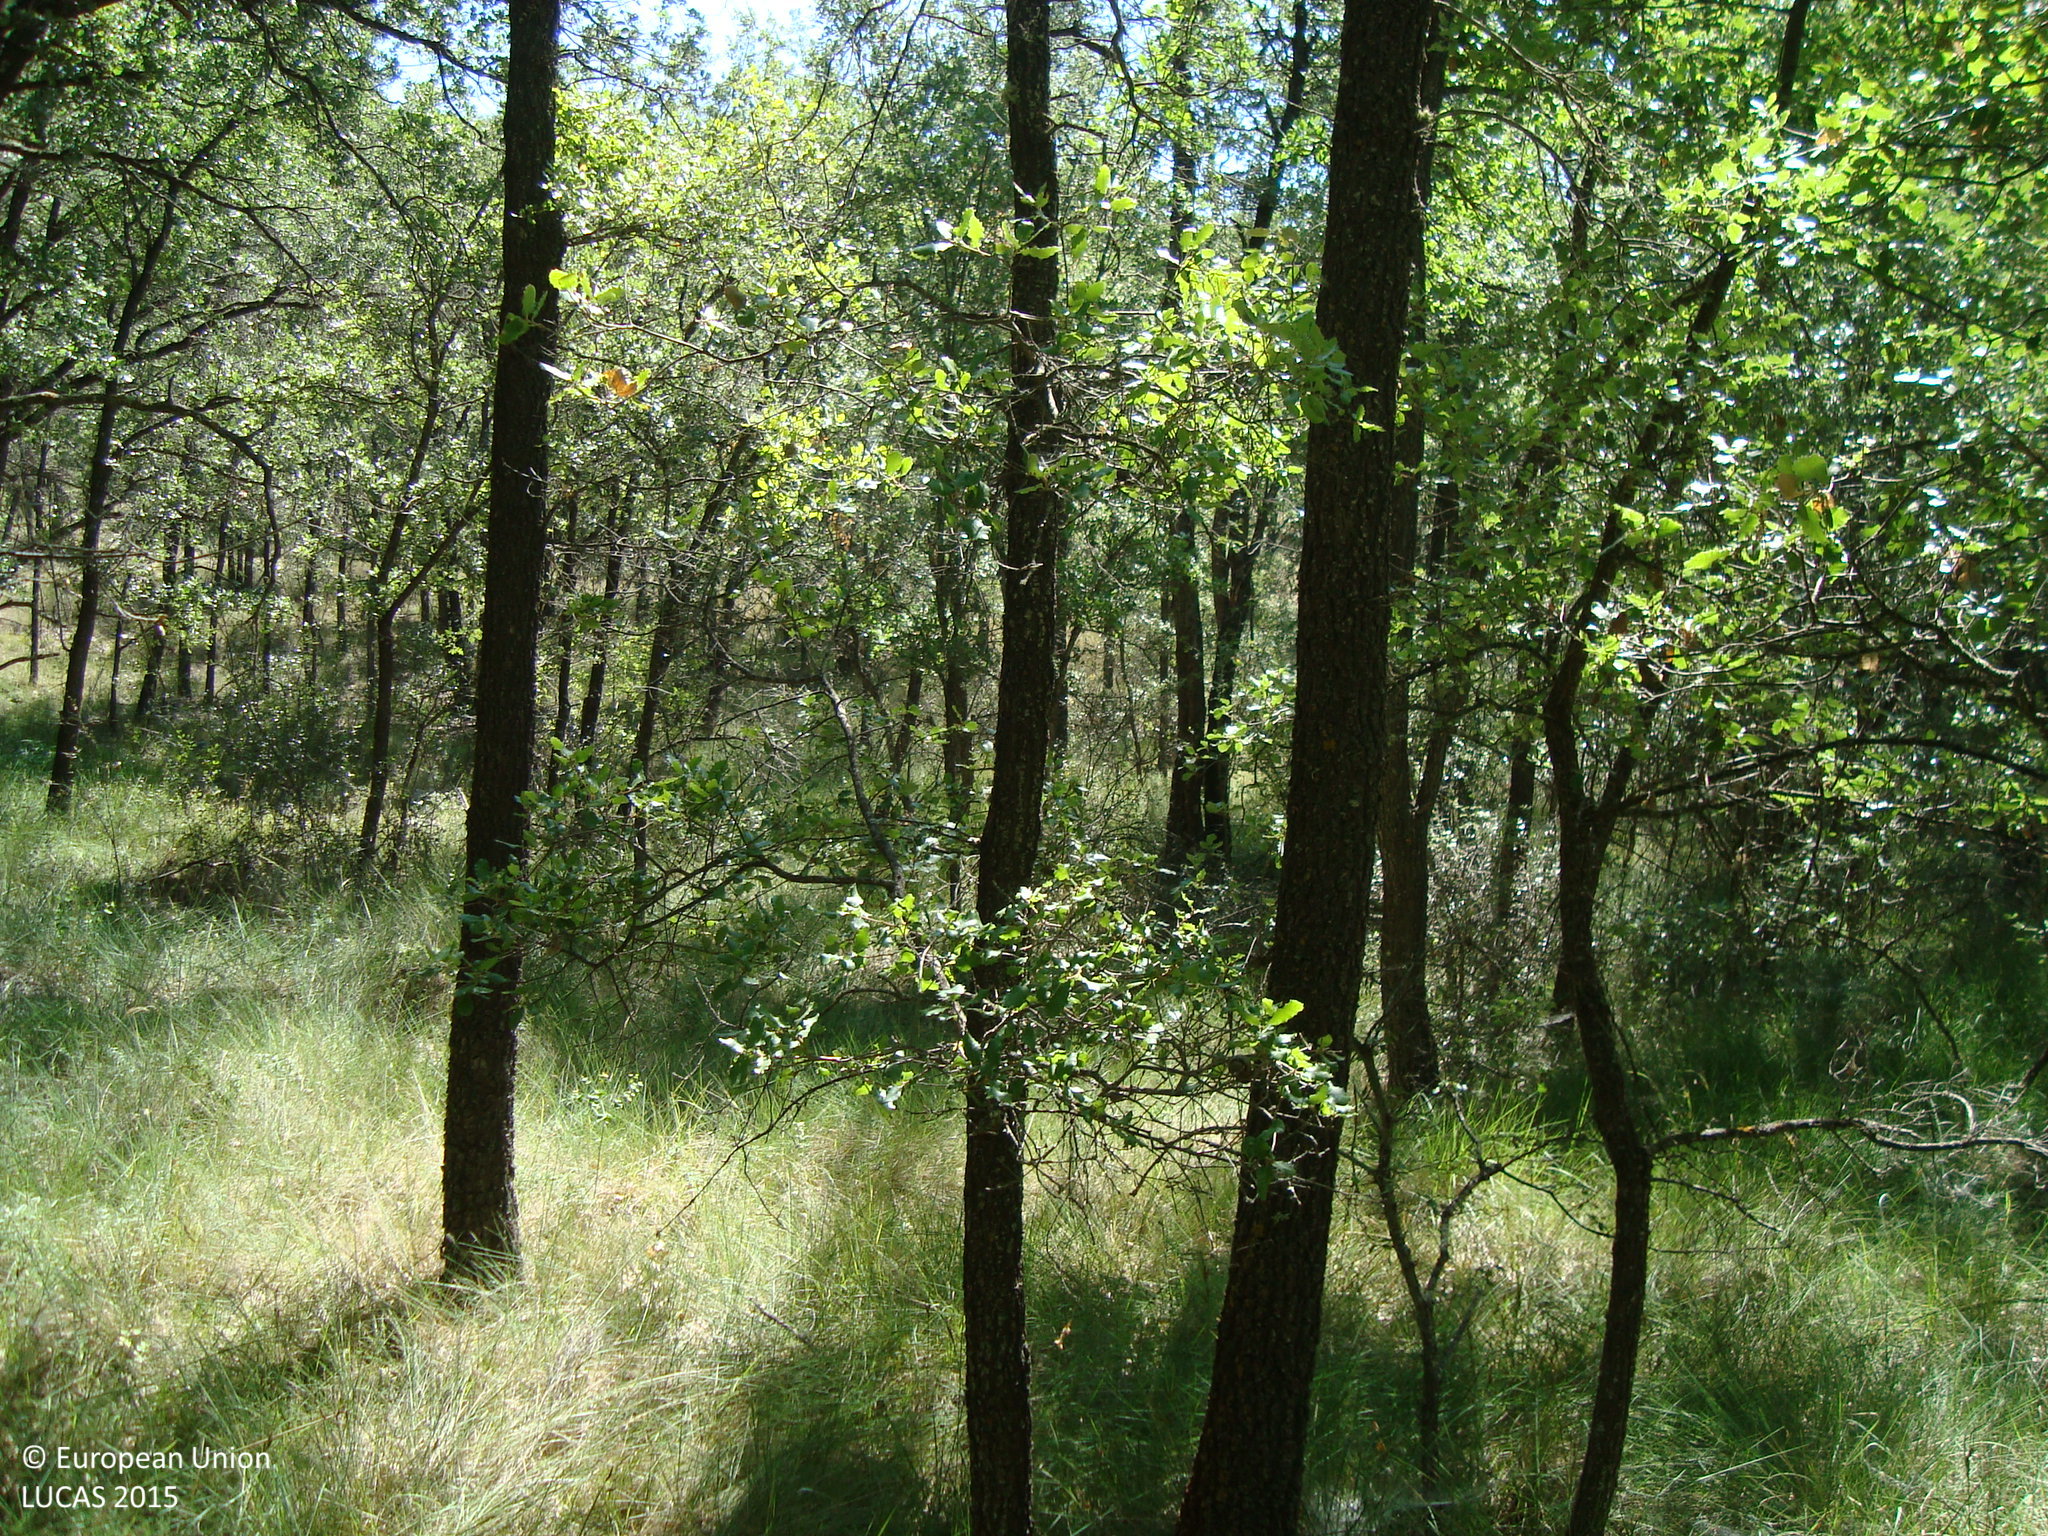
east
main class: Woodland
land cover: Broadleaved woodland
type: thermophilous deciduous forest
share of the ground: > 75 %
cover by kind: broadleaved forest trees 80 %, herbaceous plants 20 %
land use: Forestry
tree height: > 5 m
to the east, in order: Broadleaved woodland
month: July
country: ES
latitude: 41.8260
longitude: -4.2341
